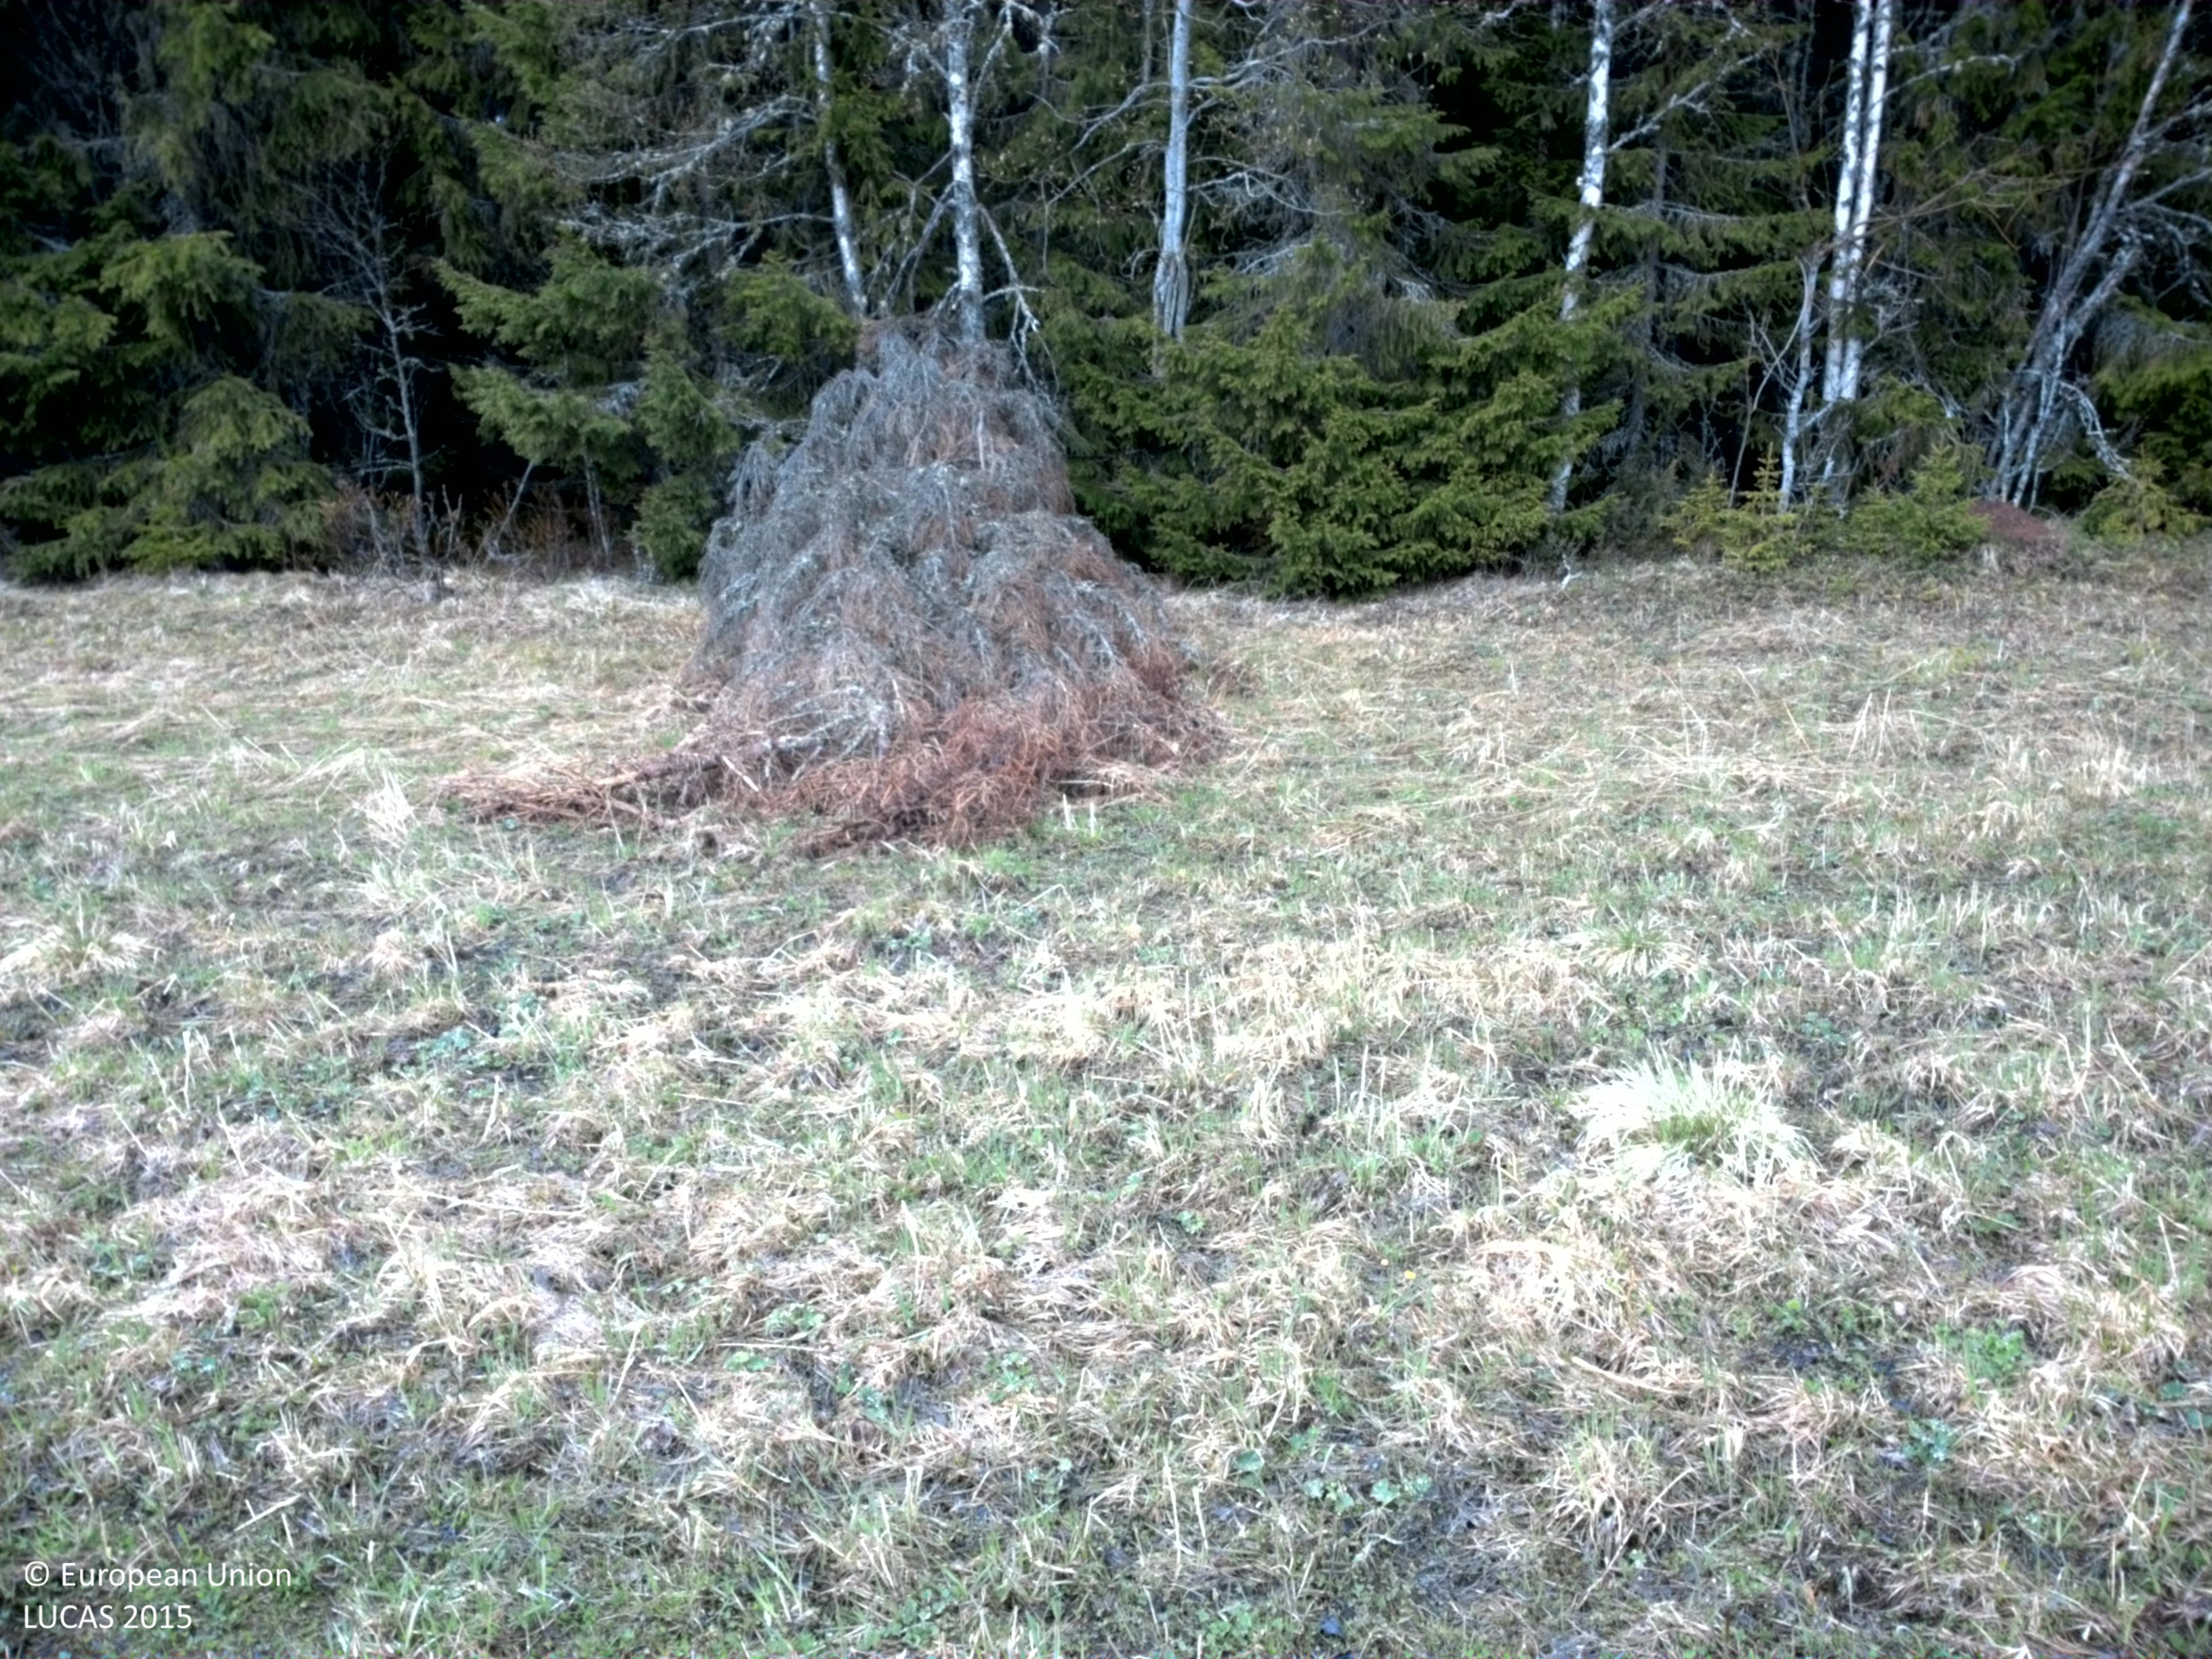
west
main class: Grassland
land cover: Grassland without tree/shrub cover
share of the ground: > 75 %
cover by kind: herbaceous plants 100 %
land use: Agriculture (excluding fallow land and kitchen gardens)
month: May
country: SE
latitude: 63.3948
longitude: 13.8035
